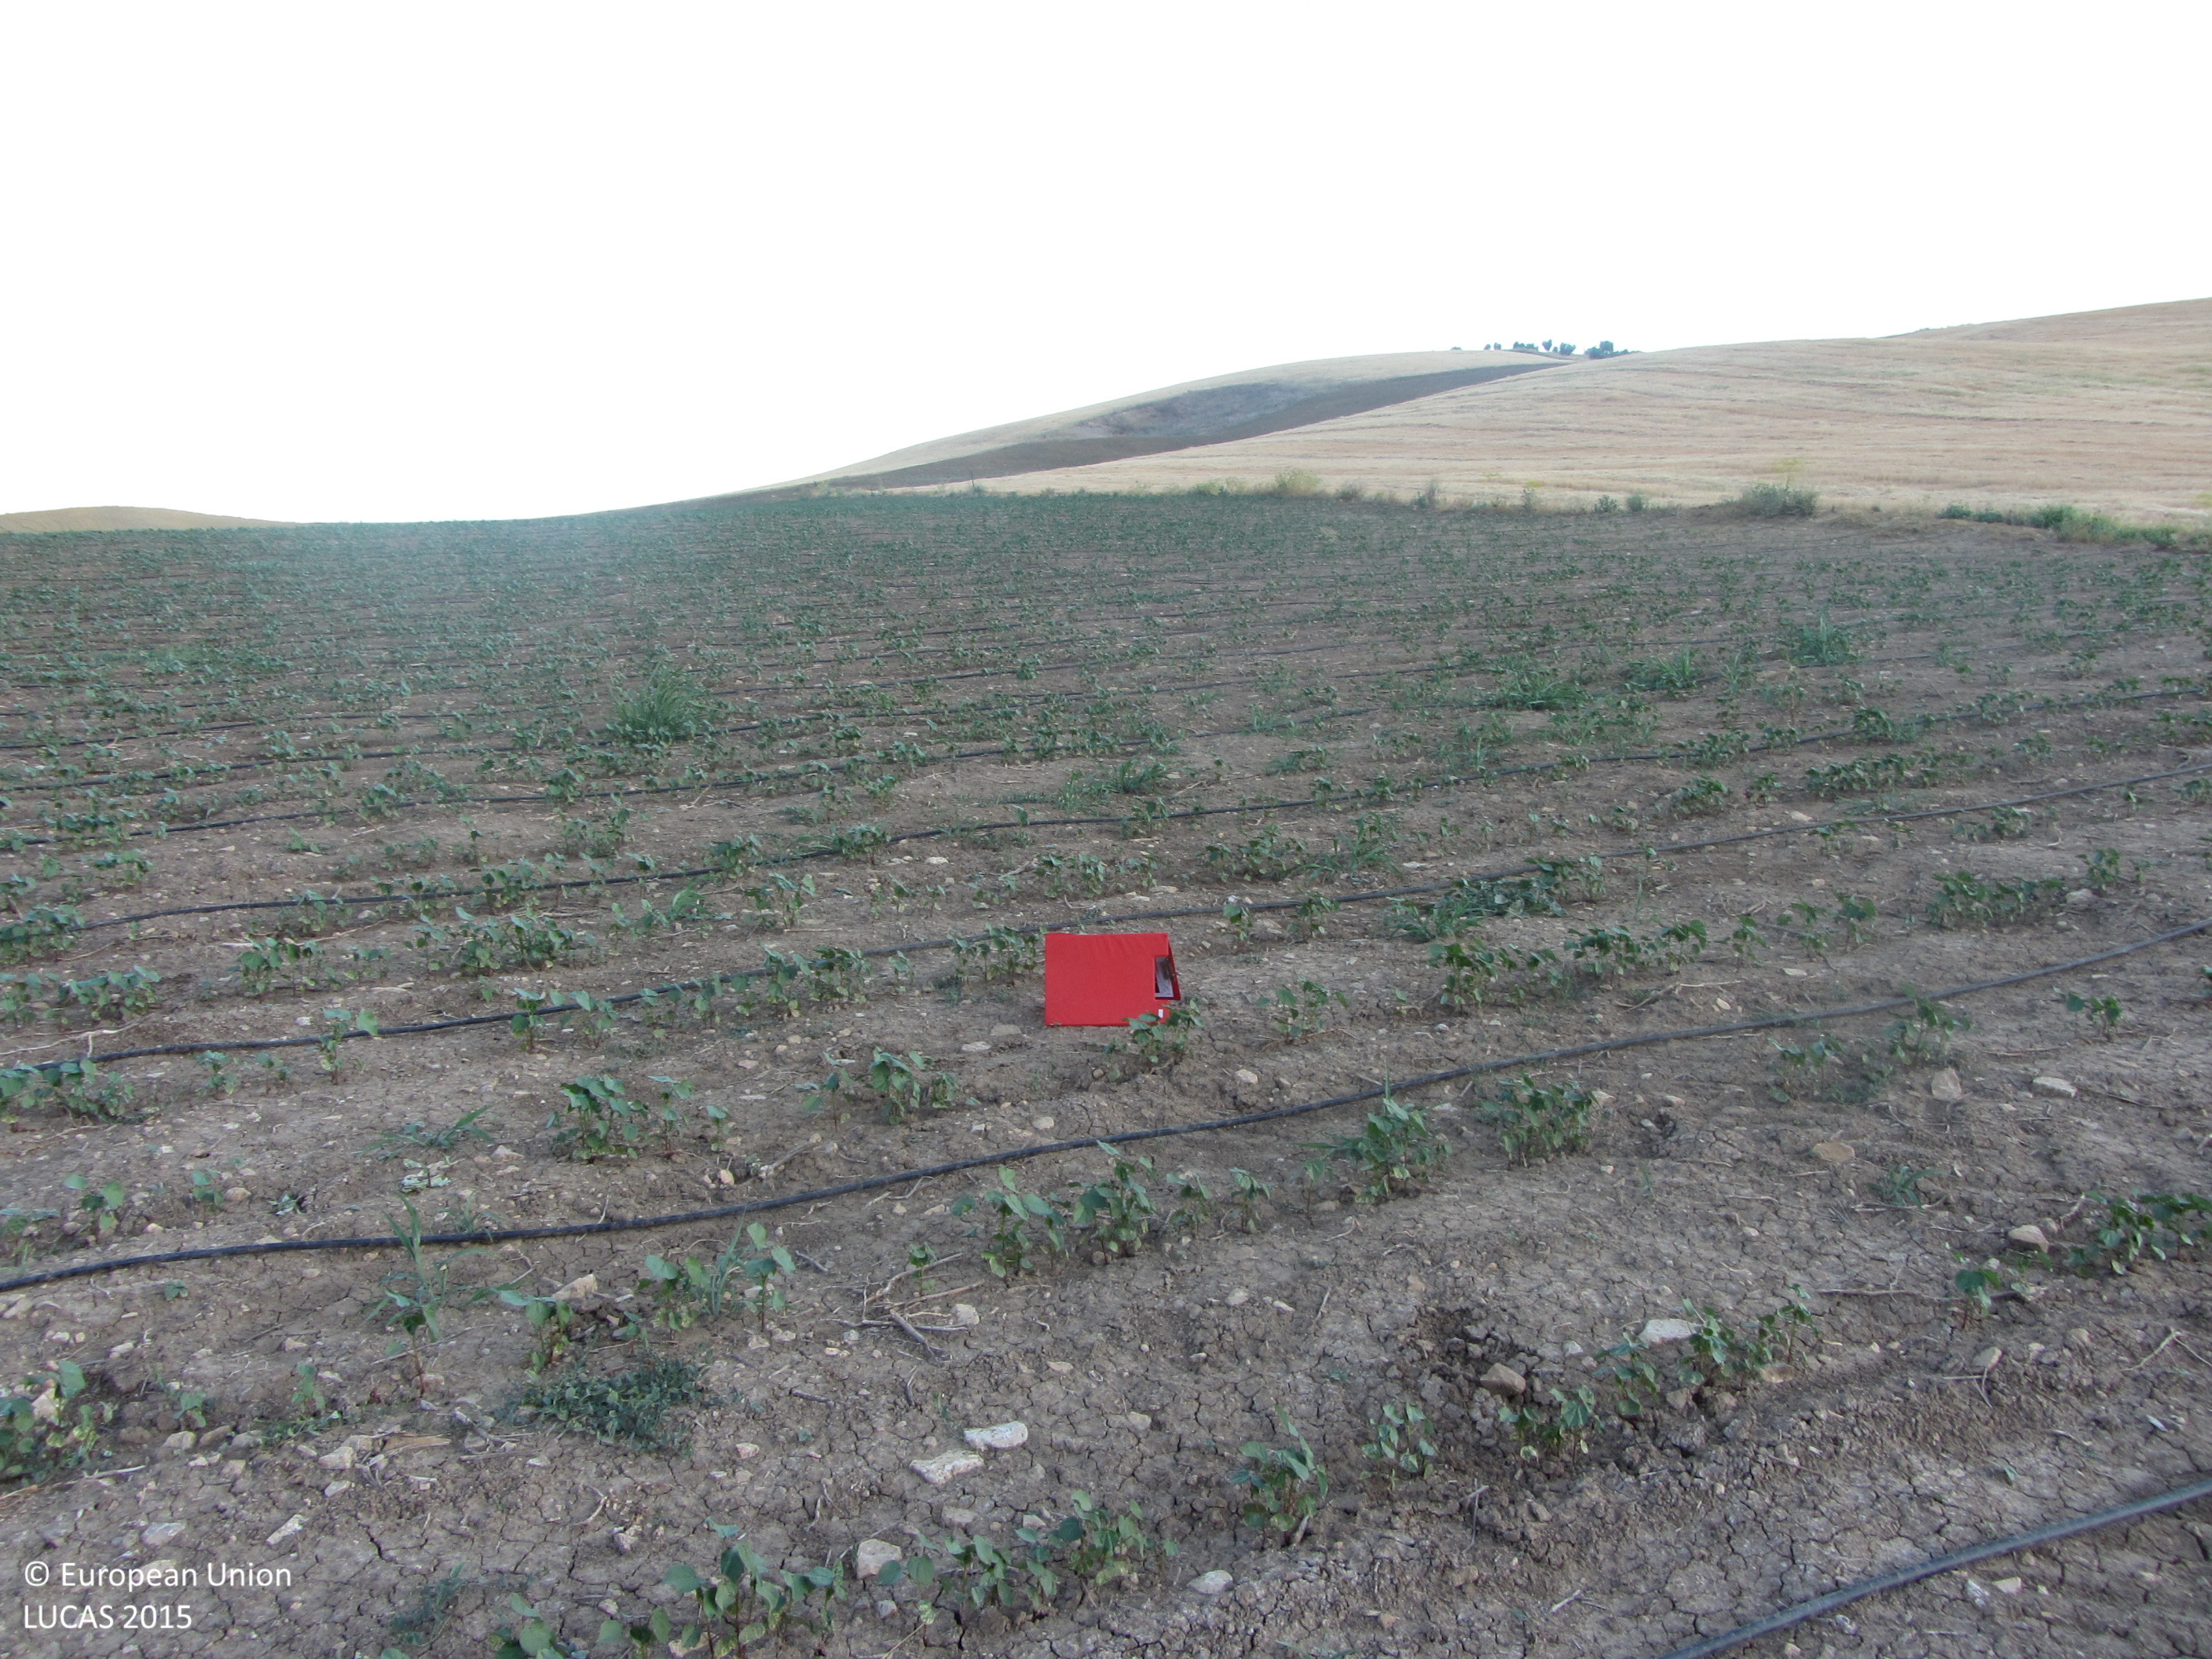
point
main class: Cropland
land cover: Cotton
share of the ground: < 10 %
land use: Agriculture (excluding fallow land and kitchen gardens)
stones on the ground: < 10 %
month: June
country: ES
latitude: 37.9292
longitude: -3.8036
